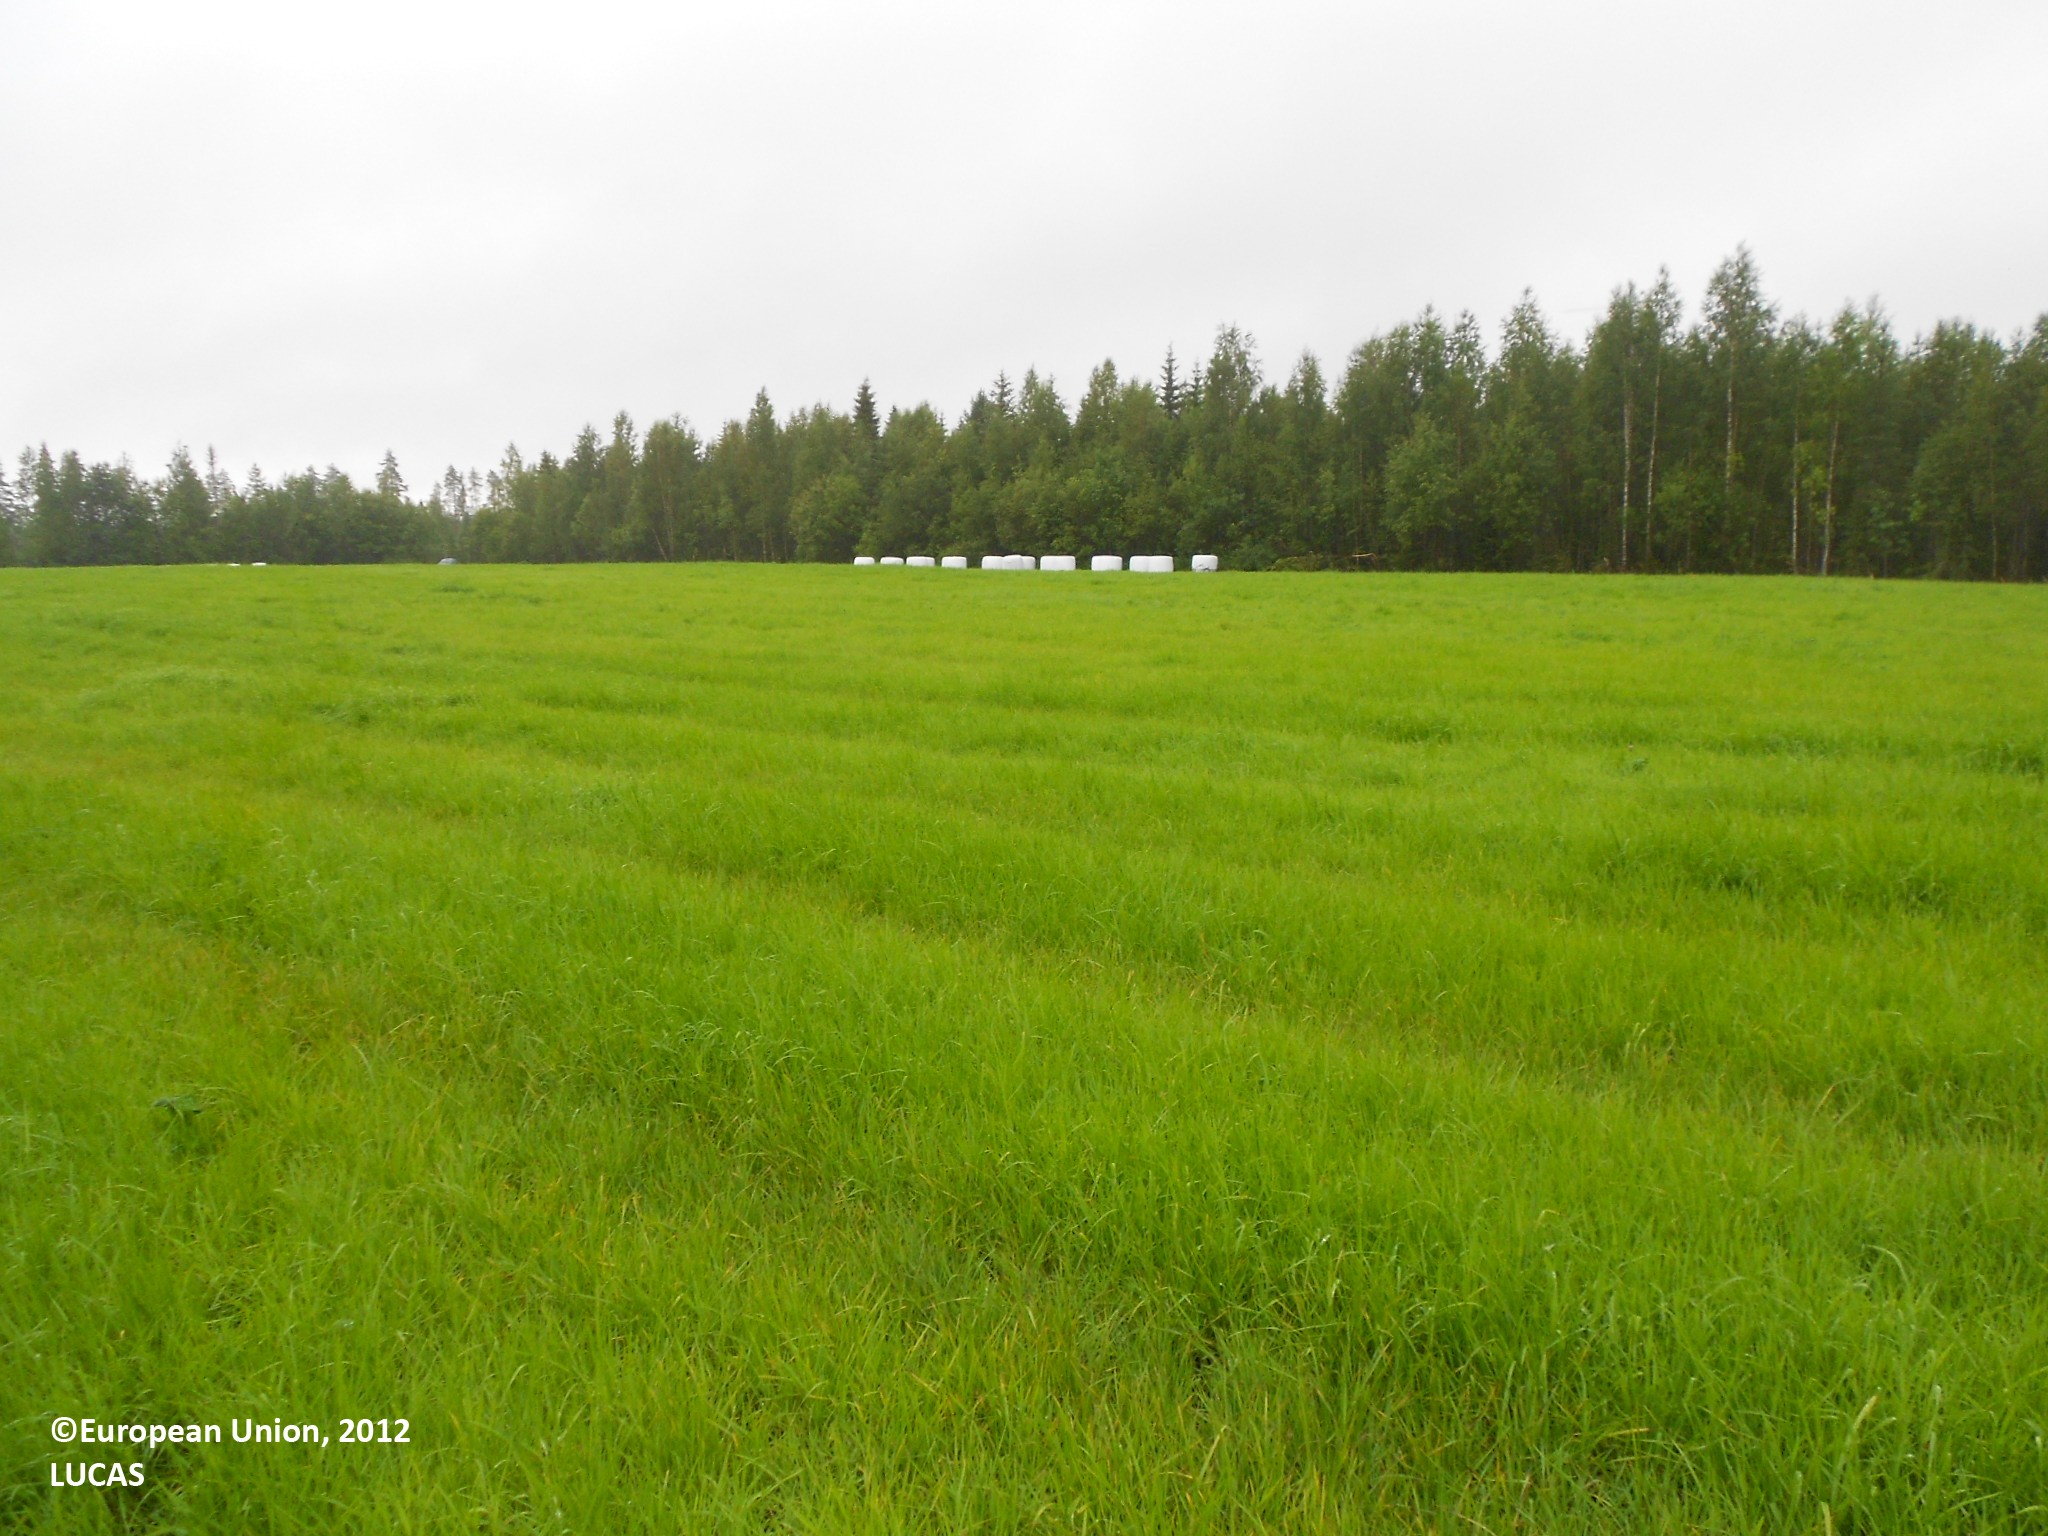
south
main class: Cropland
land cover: Temporary grasslands
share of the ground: > 75 %
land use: Agriculture (excluding fallow land and kitchen gardens)
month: August
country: FI
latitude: 63.9943
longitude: 28.2656
